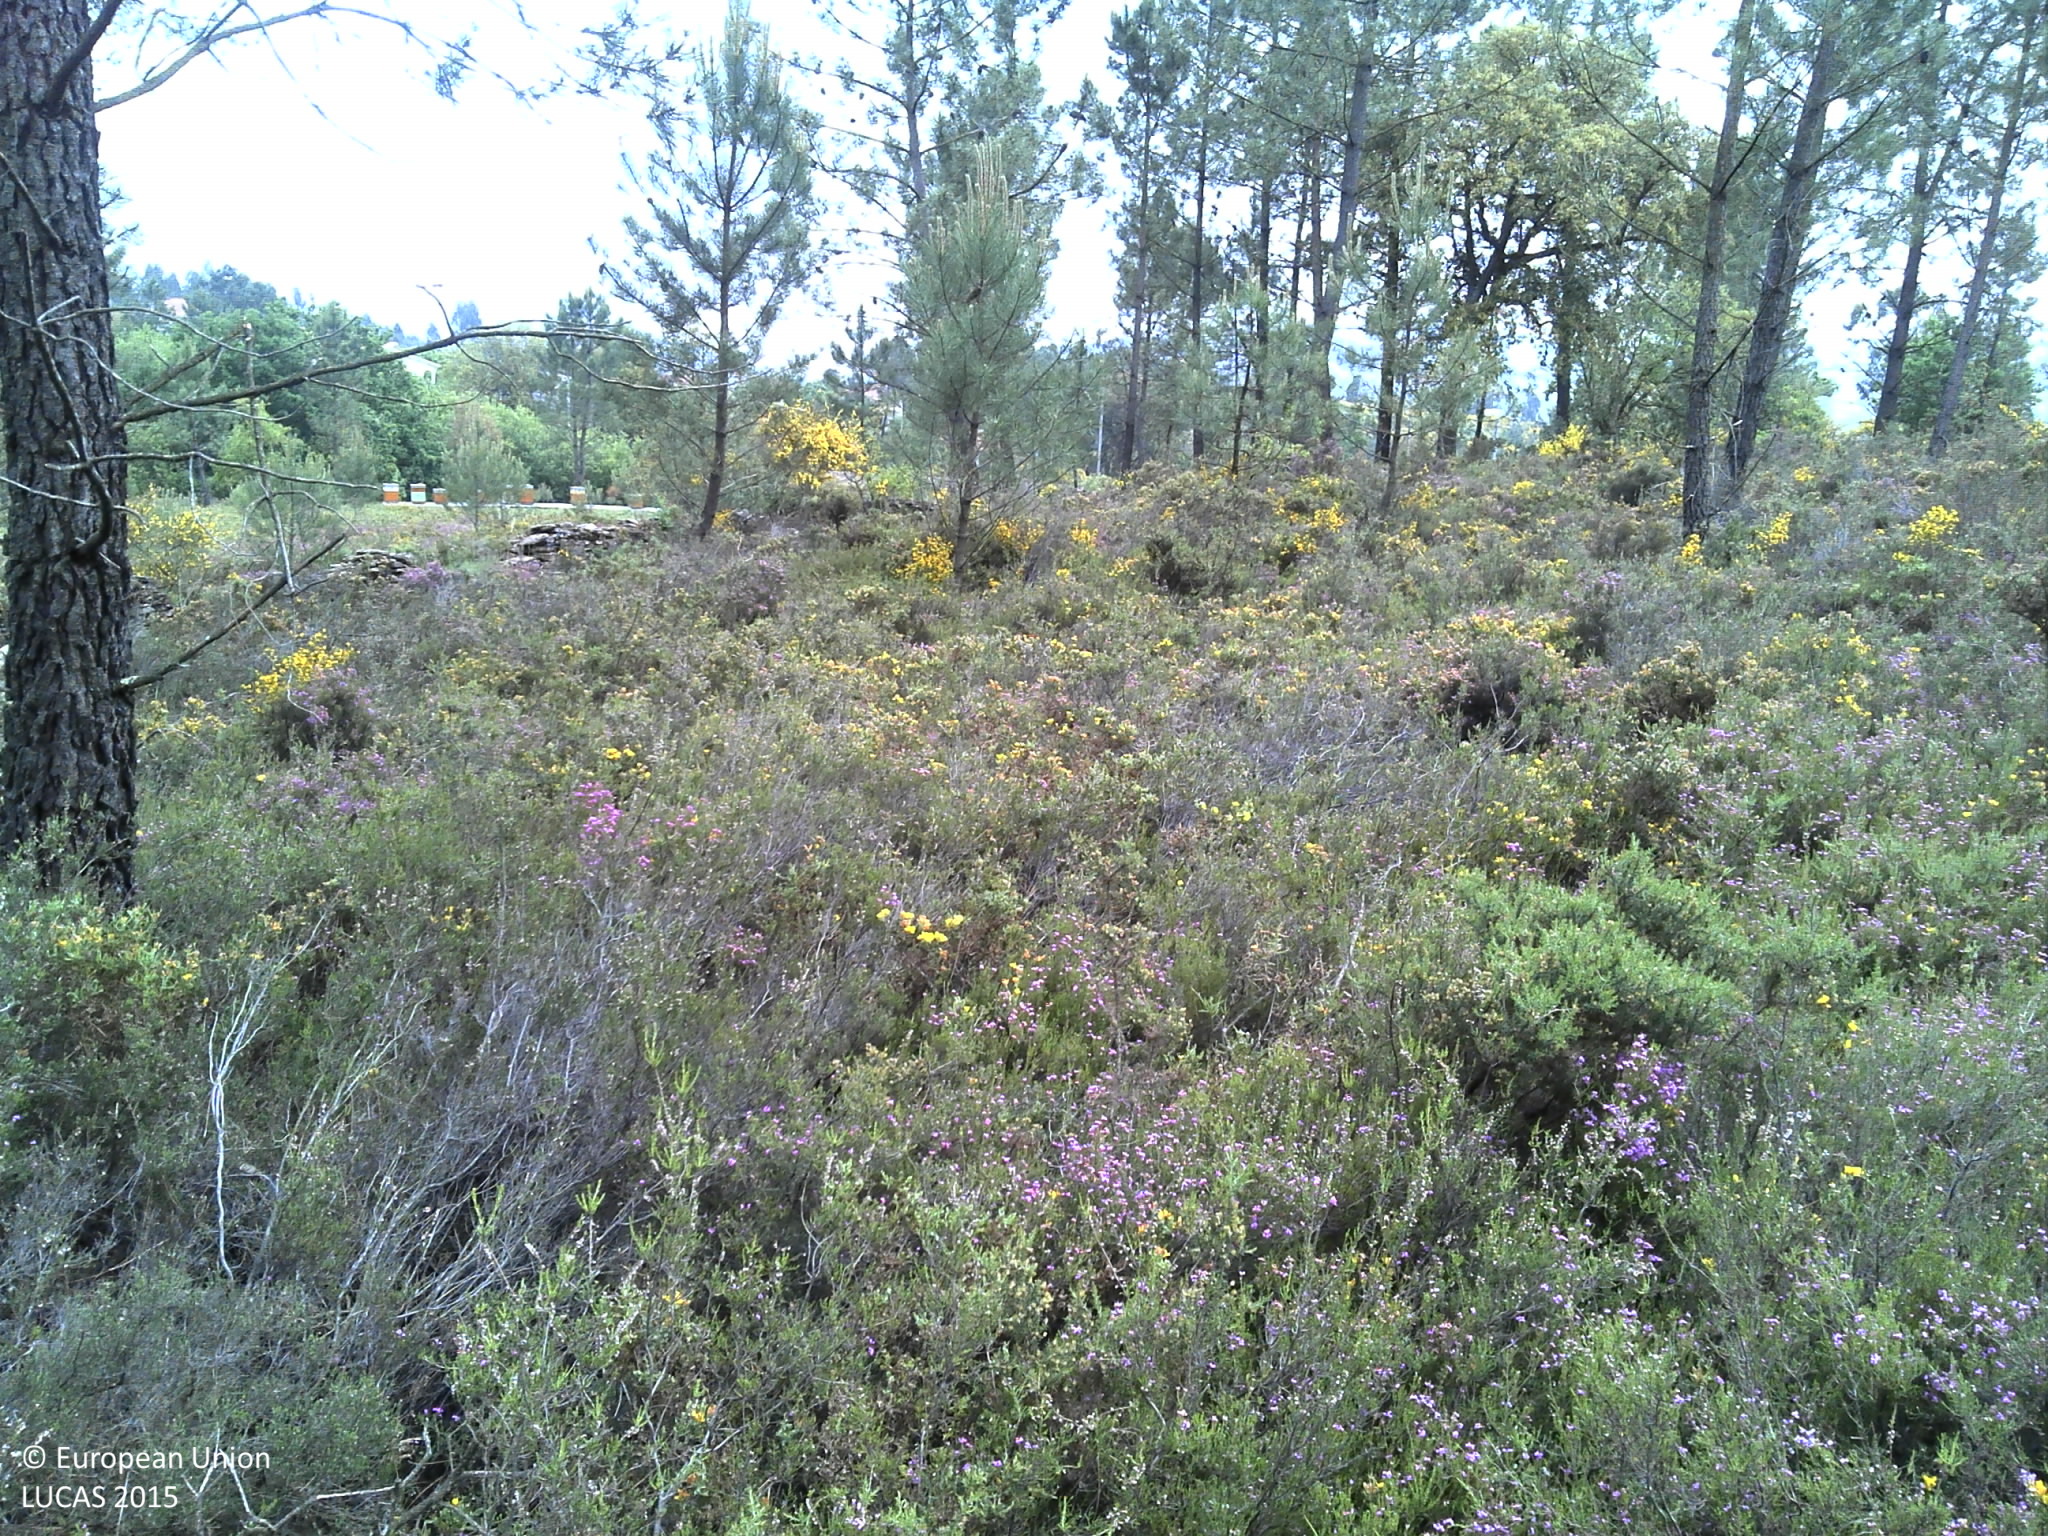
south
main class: Shrubland
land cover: Shrubland with sparse tree cover
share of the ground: > 75 %
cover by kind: shrubs 85 %, unconsolidated bare surface 10 %, broadleaved forest trees 5 %
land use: Forestry
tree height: > 5 m
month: May
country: PT
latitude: 41.1648
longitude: -8.4423
